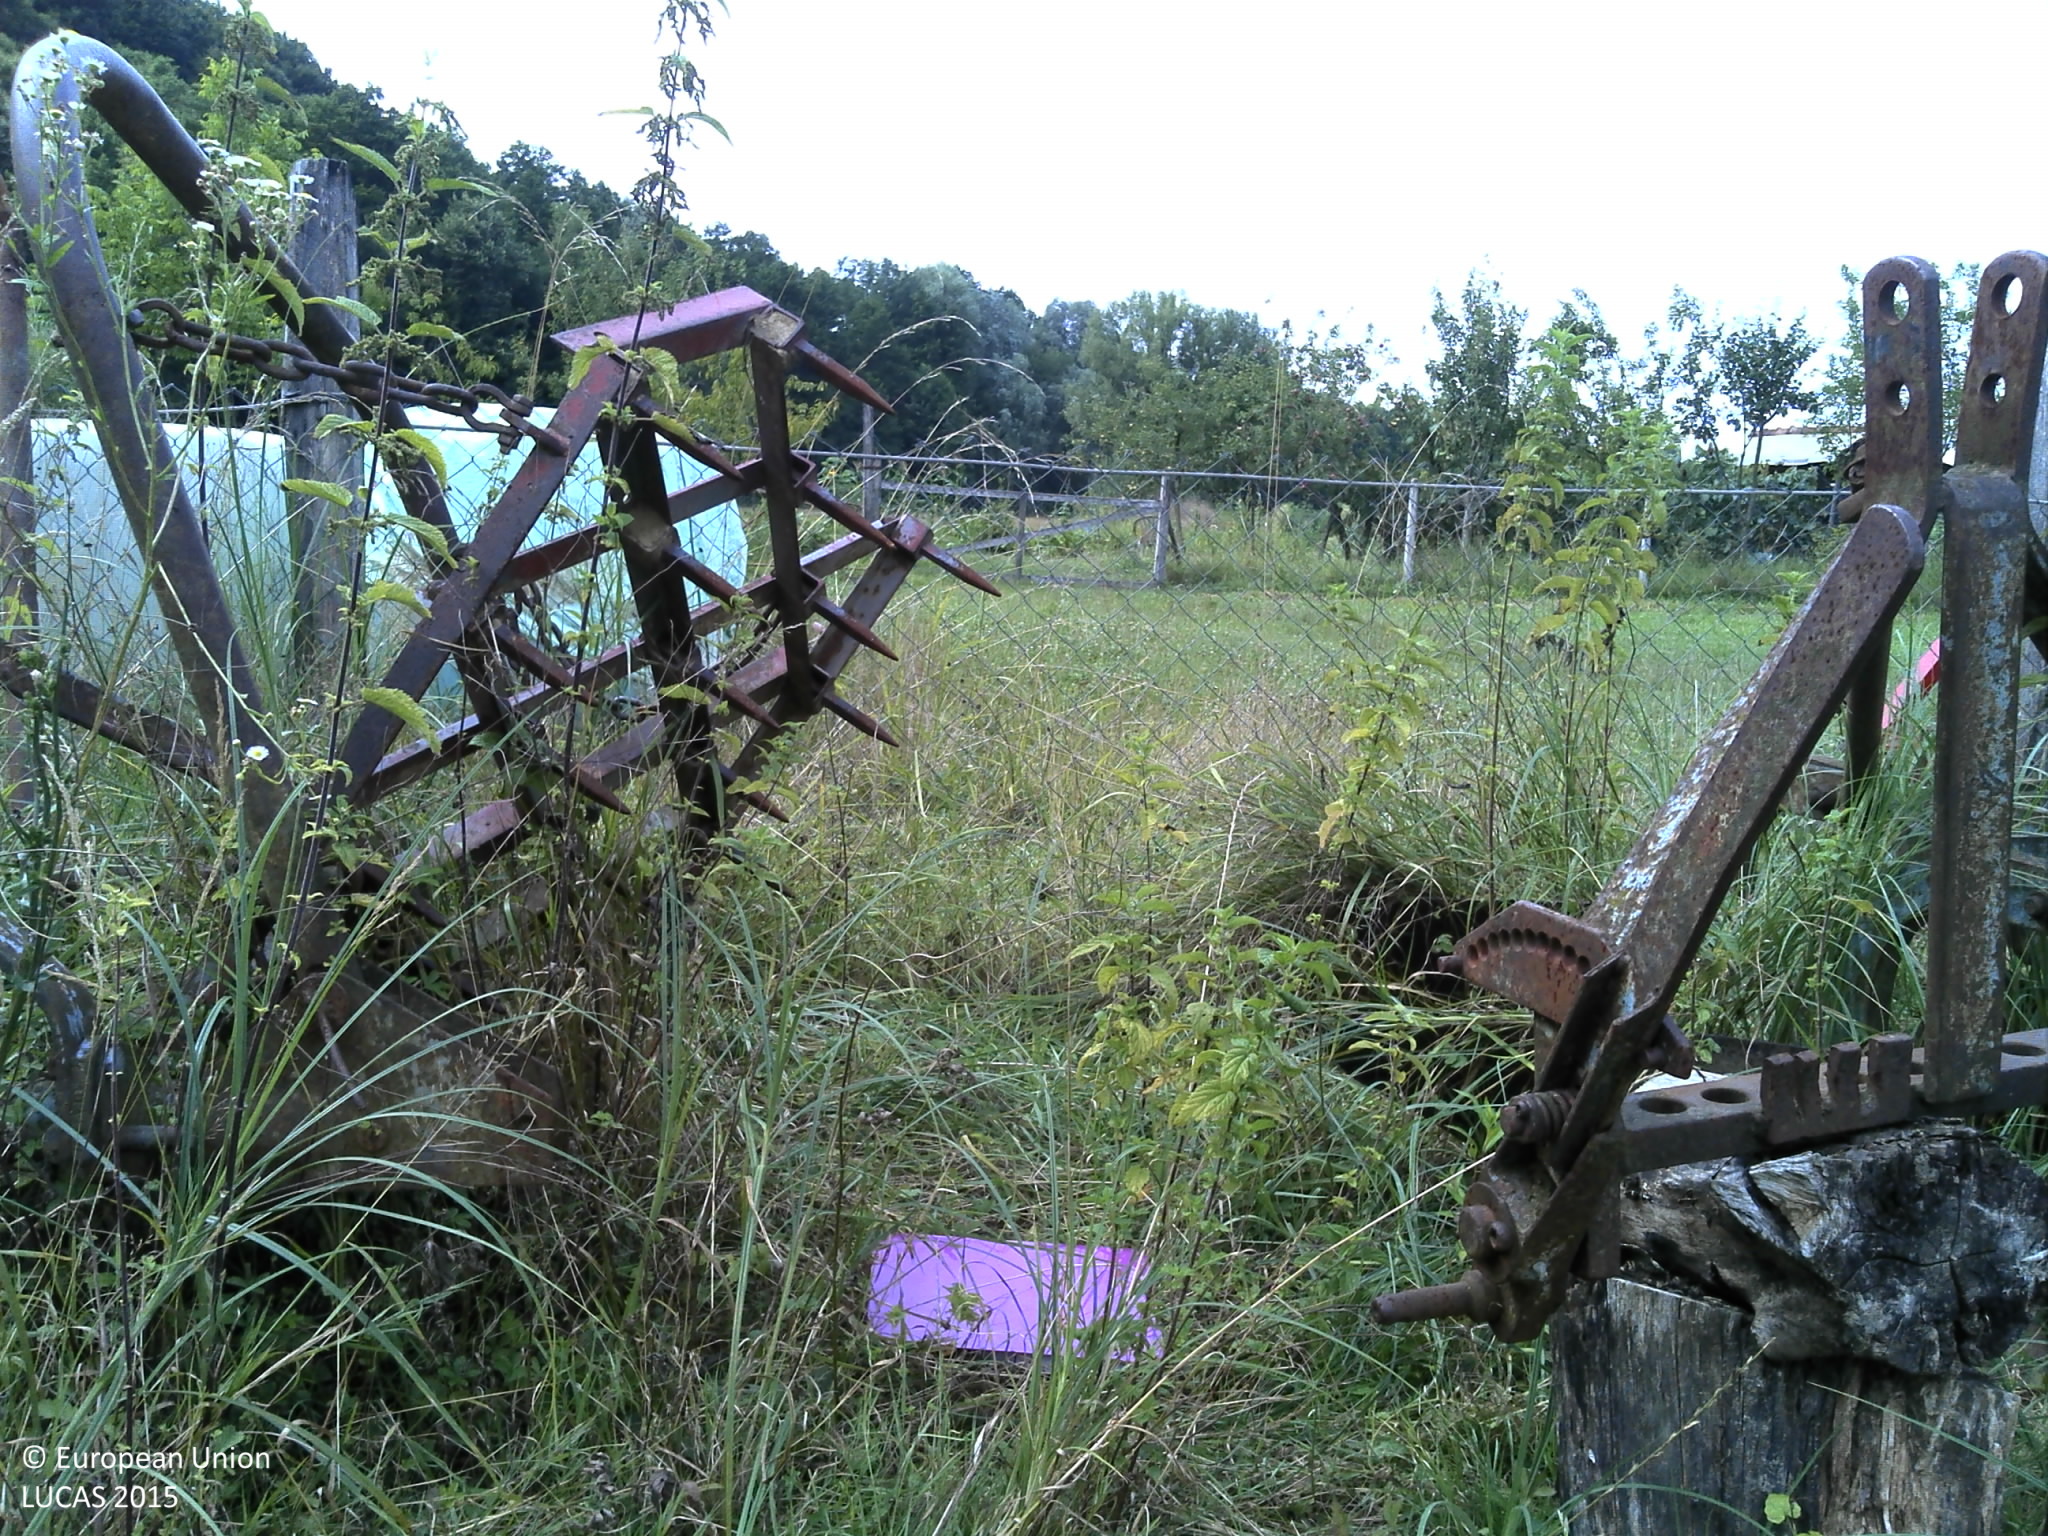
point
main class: Grassland
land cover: Spontaneously vegetated surfaces
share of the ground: > 75 %
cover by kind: herbaceous plants 100 %
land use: Fallow land
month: July
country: HR
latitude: 45.6511
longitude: 17.2769
